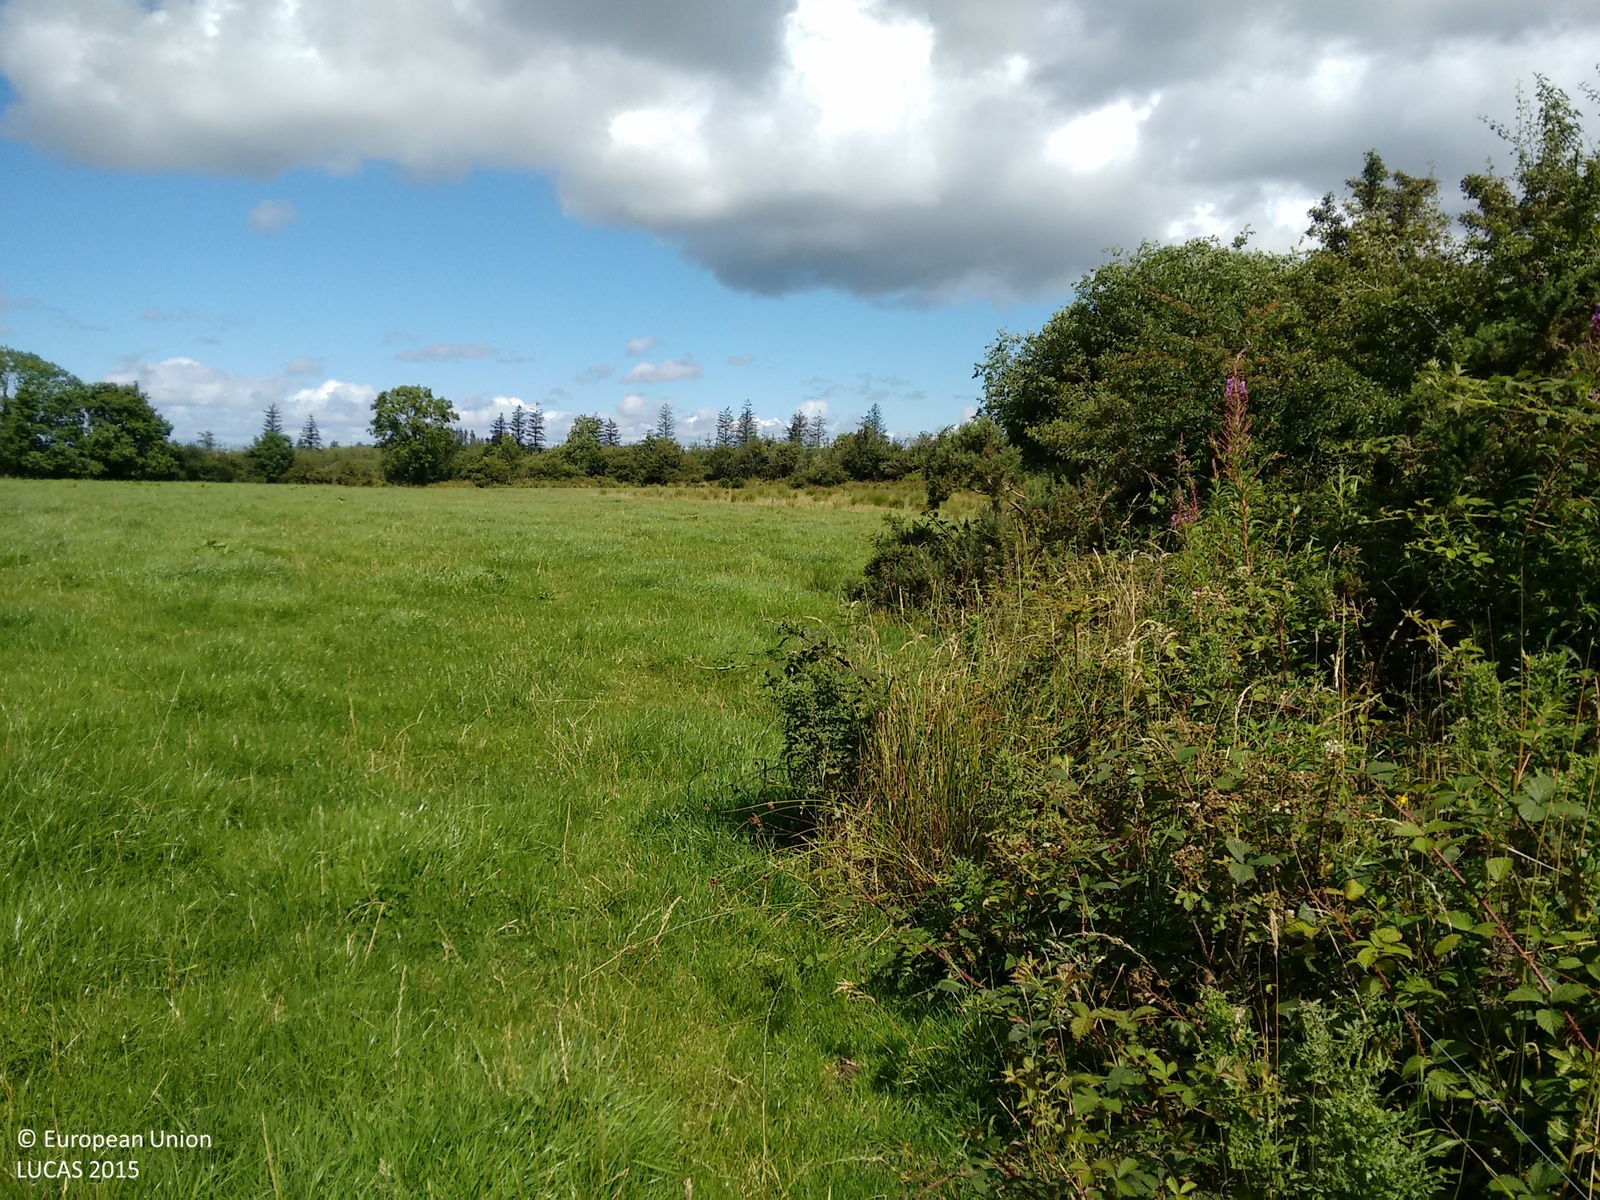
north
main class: Woodland
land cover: Broadleaved woodland
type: mesophytic deciduous forest
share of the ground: > 75 %
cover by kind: broadleaved forest trees 85 %, shrubs 15 %
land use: Forestry
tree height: > 5 m
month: August
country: IE
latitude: 52.4034
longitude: -7.1540
